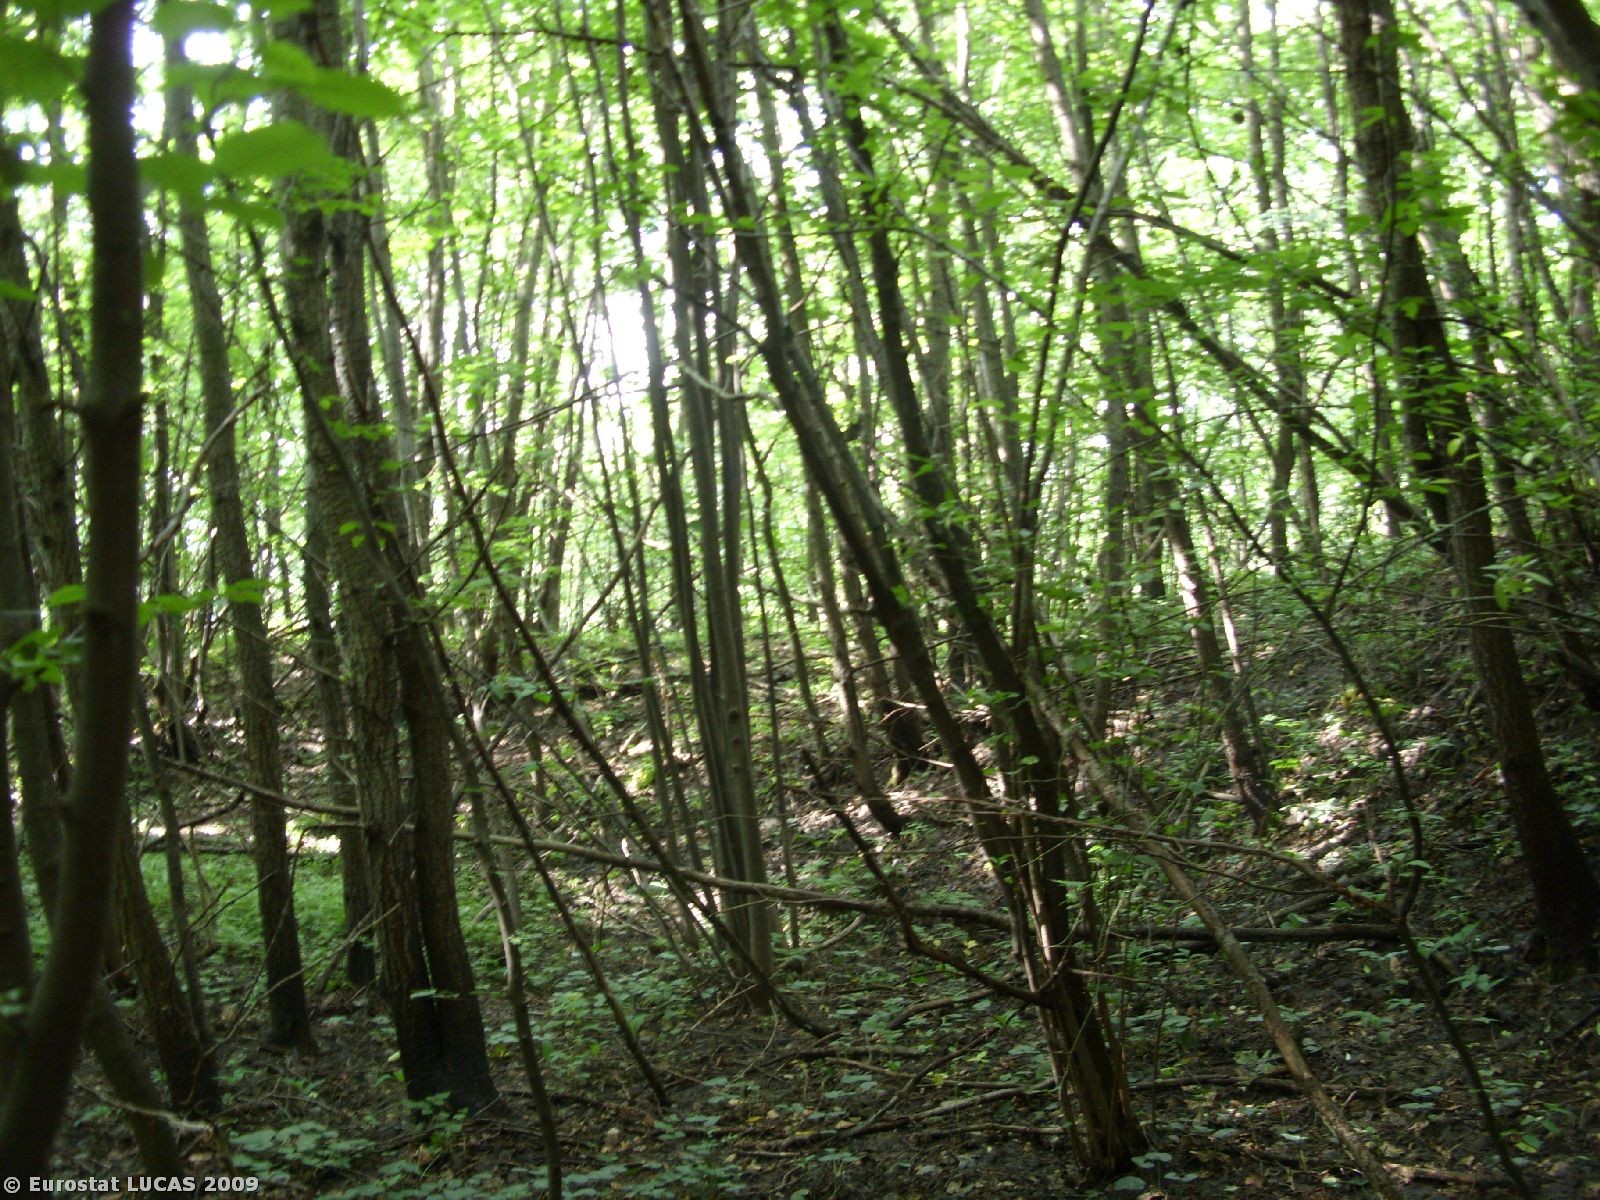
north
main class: Woodland
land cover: Broadleaved woodland
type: mesophytic deciduous forest
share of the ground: > 75 %
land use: Unused
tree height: > 5 m
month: June
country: PL
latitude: 49.8904
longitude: 20.1812
